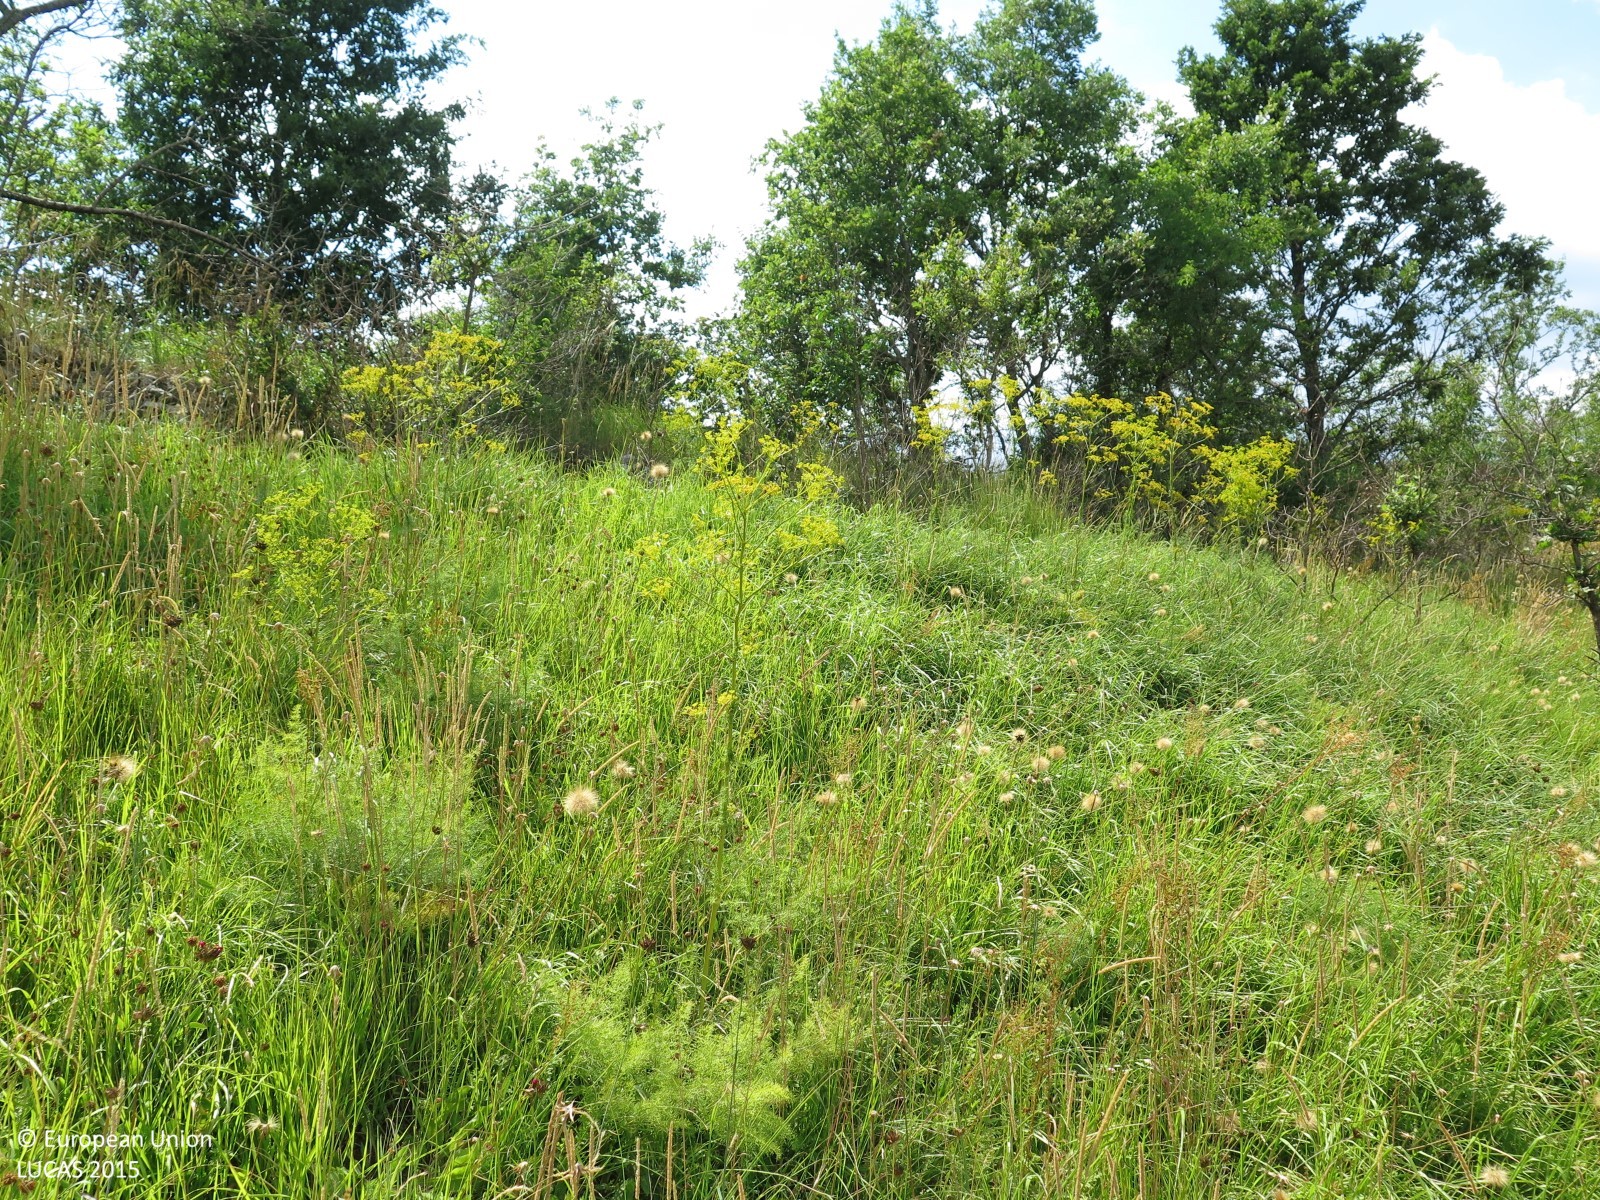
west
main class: Grassland
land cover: Grassland without tree/shrub cover
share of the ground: > 75 %
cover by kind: herbaceous plants 100 %
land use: Abandoned areas
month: June
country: HR
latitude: 45.1540
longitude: 14.1031
